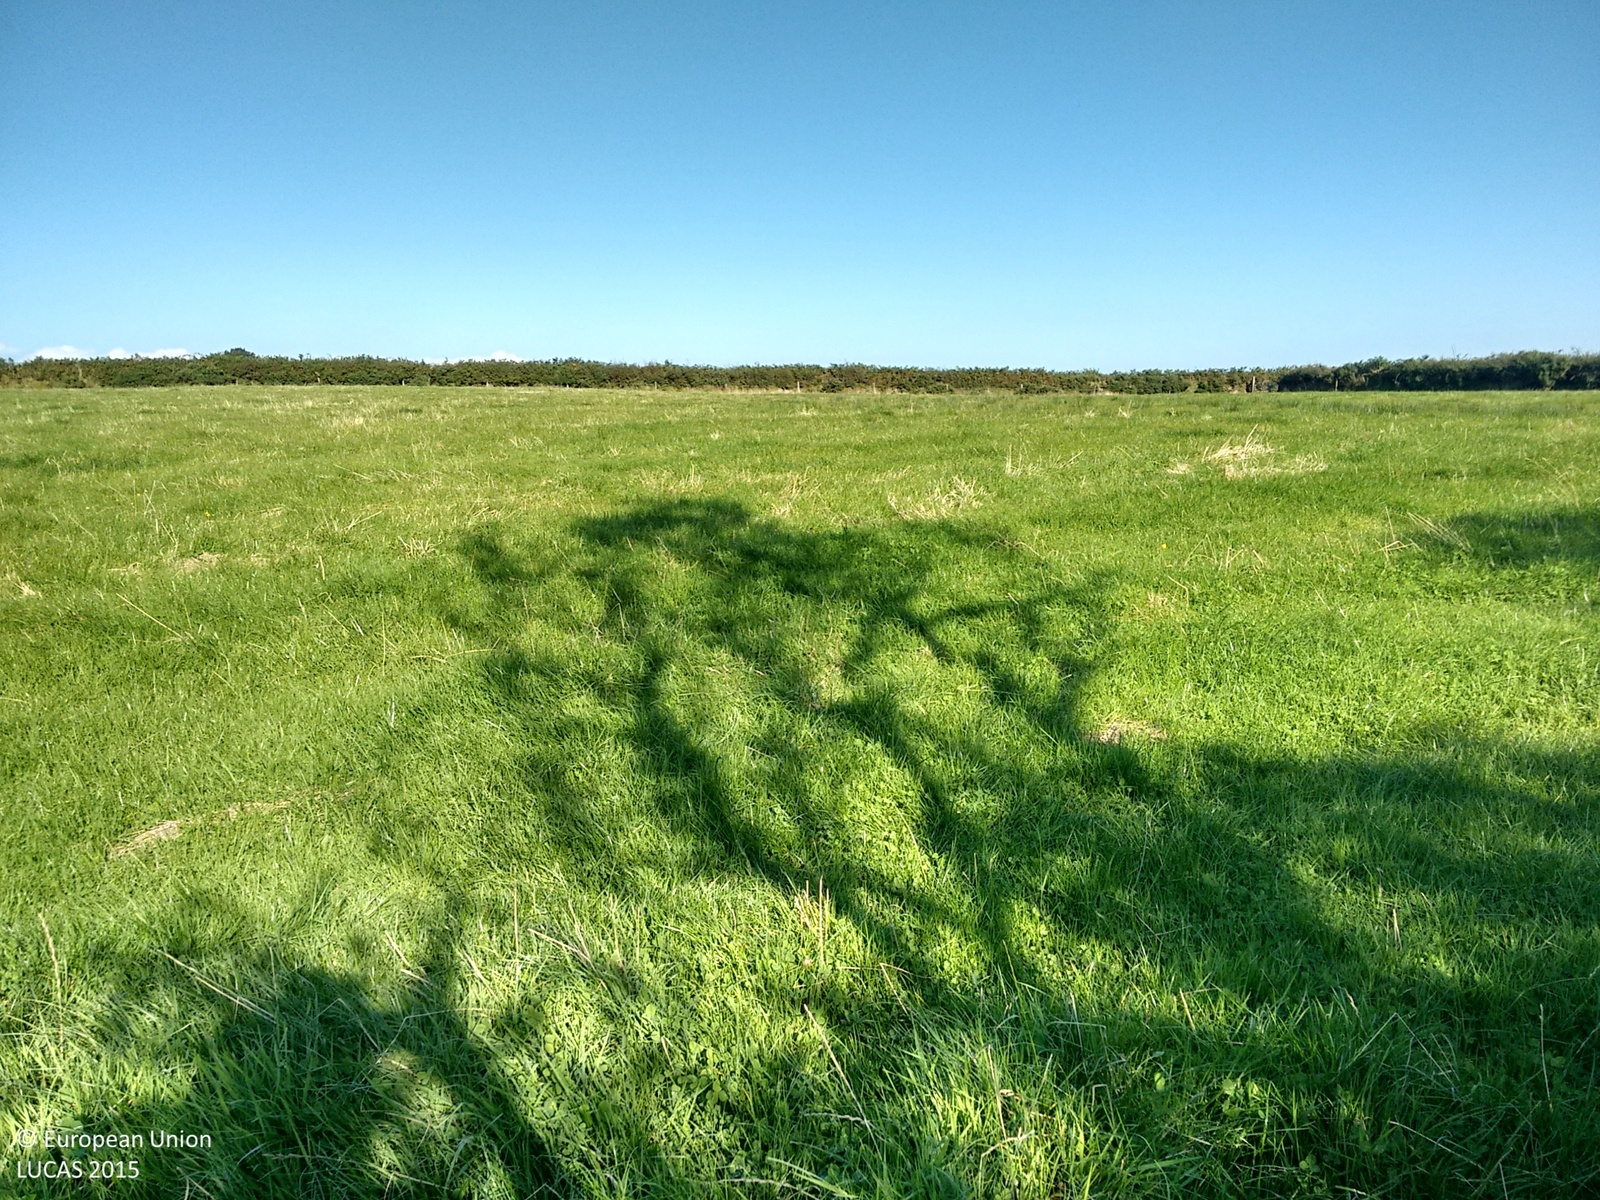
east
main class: Grassland
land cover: Grassland without tree/shrub cover
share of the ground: > 75 %
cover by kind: herbaceous plants 100 %
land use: Agriculture (excluding fallow land and kitchen gardens)
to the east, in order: Grassland without tree/shrub cover; Fences; Managed hedges; Fences; Grassland without tree/shrub cover; Fences; Managed hedges; Artificial constructions; Fences; Grassland without tree/shrub cover; Fences; Managed hedges; Artificial constructions; Fences; Grassland without tree/shrub cover
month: September
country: GB
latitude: 50.8879
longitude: -4.4180
